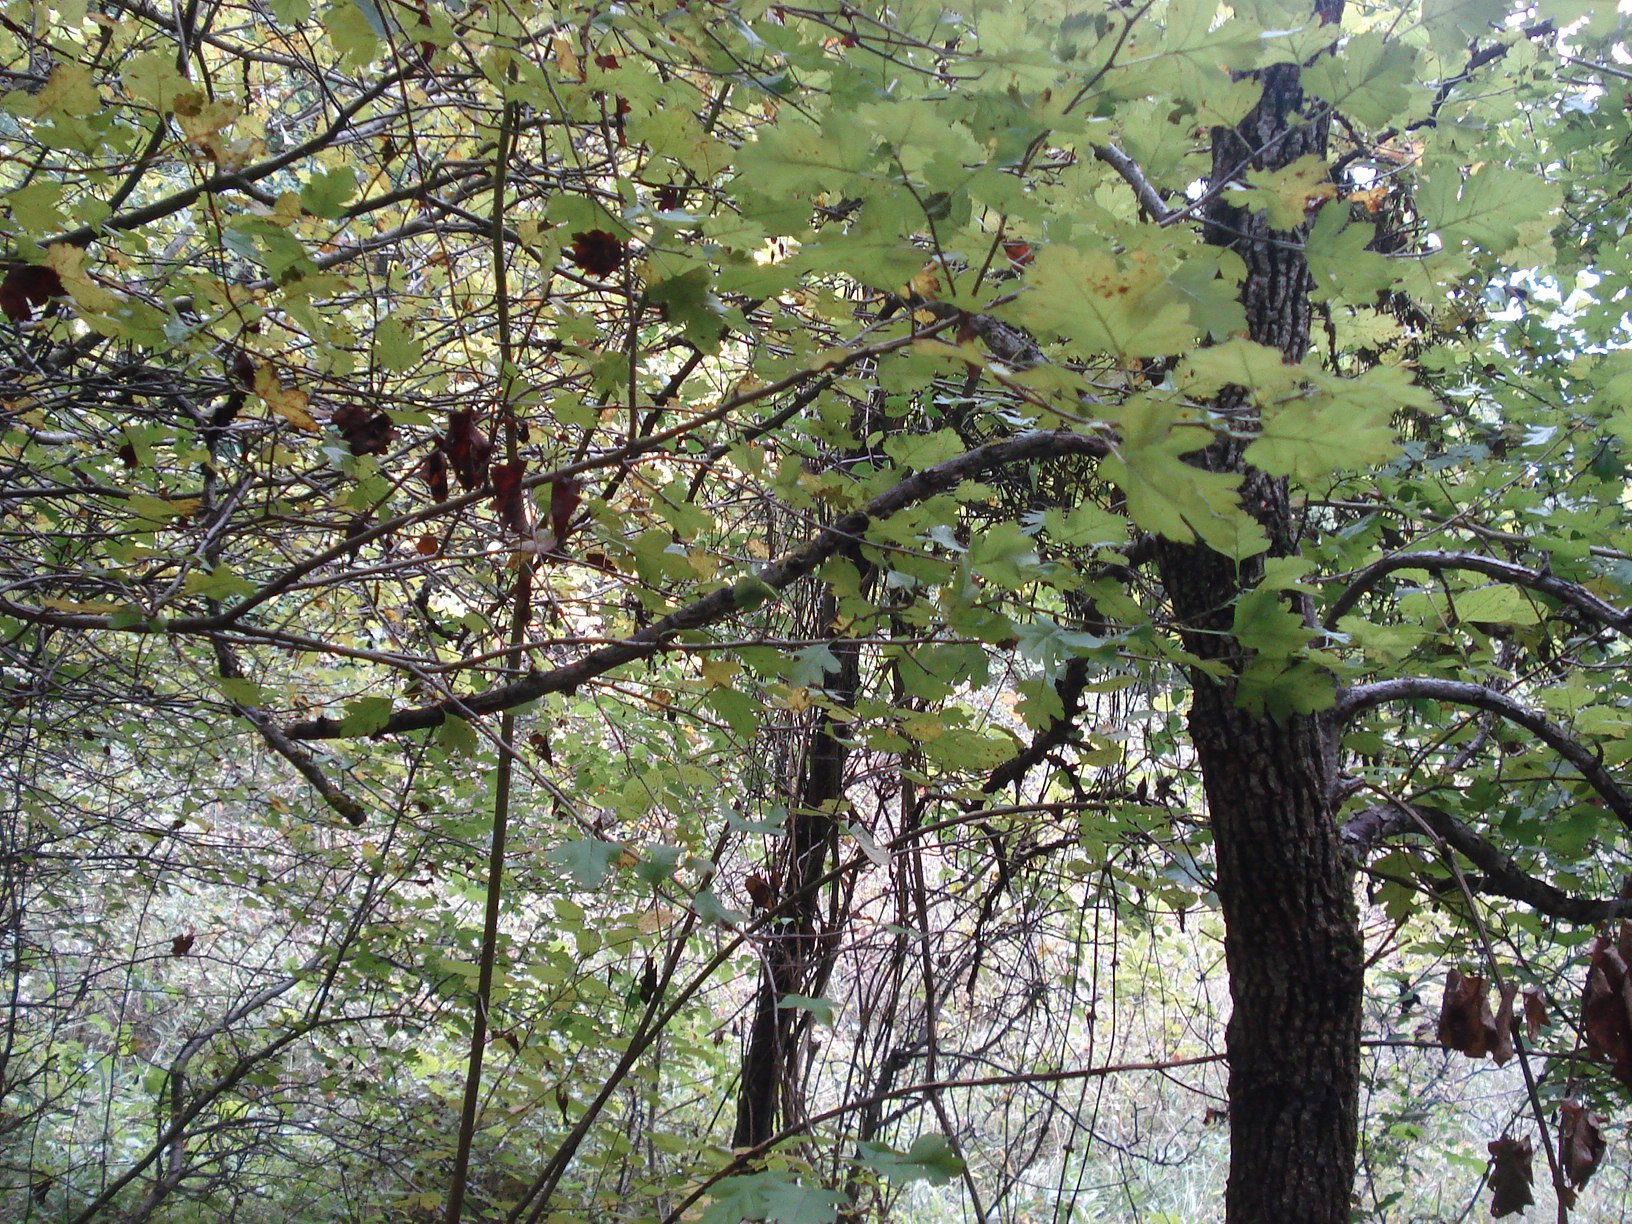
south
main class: Woodland
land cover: Broadleaved woodland
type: mesophytic deciduous forest
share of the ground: > 75 %
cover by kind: broadleaved forest trees 80 %, unconsolidated bare surface 10 %, shrubs 5 %, herbaceous plants 5 %
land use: Forestry
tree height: > 5 m
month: October
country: BG
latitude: 43.0857
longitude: 25.9702
